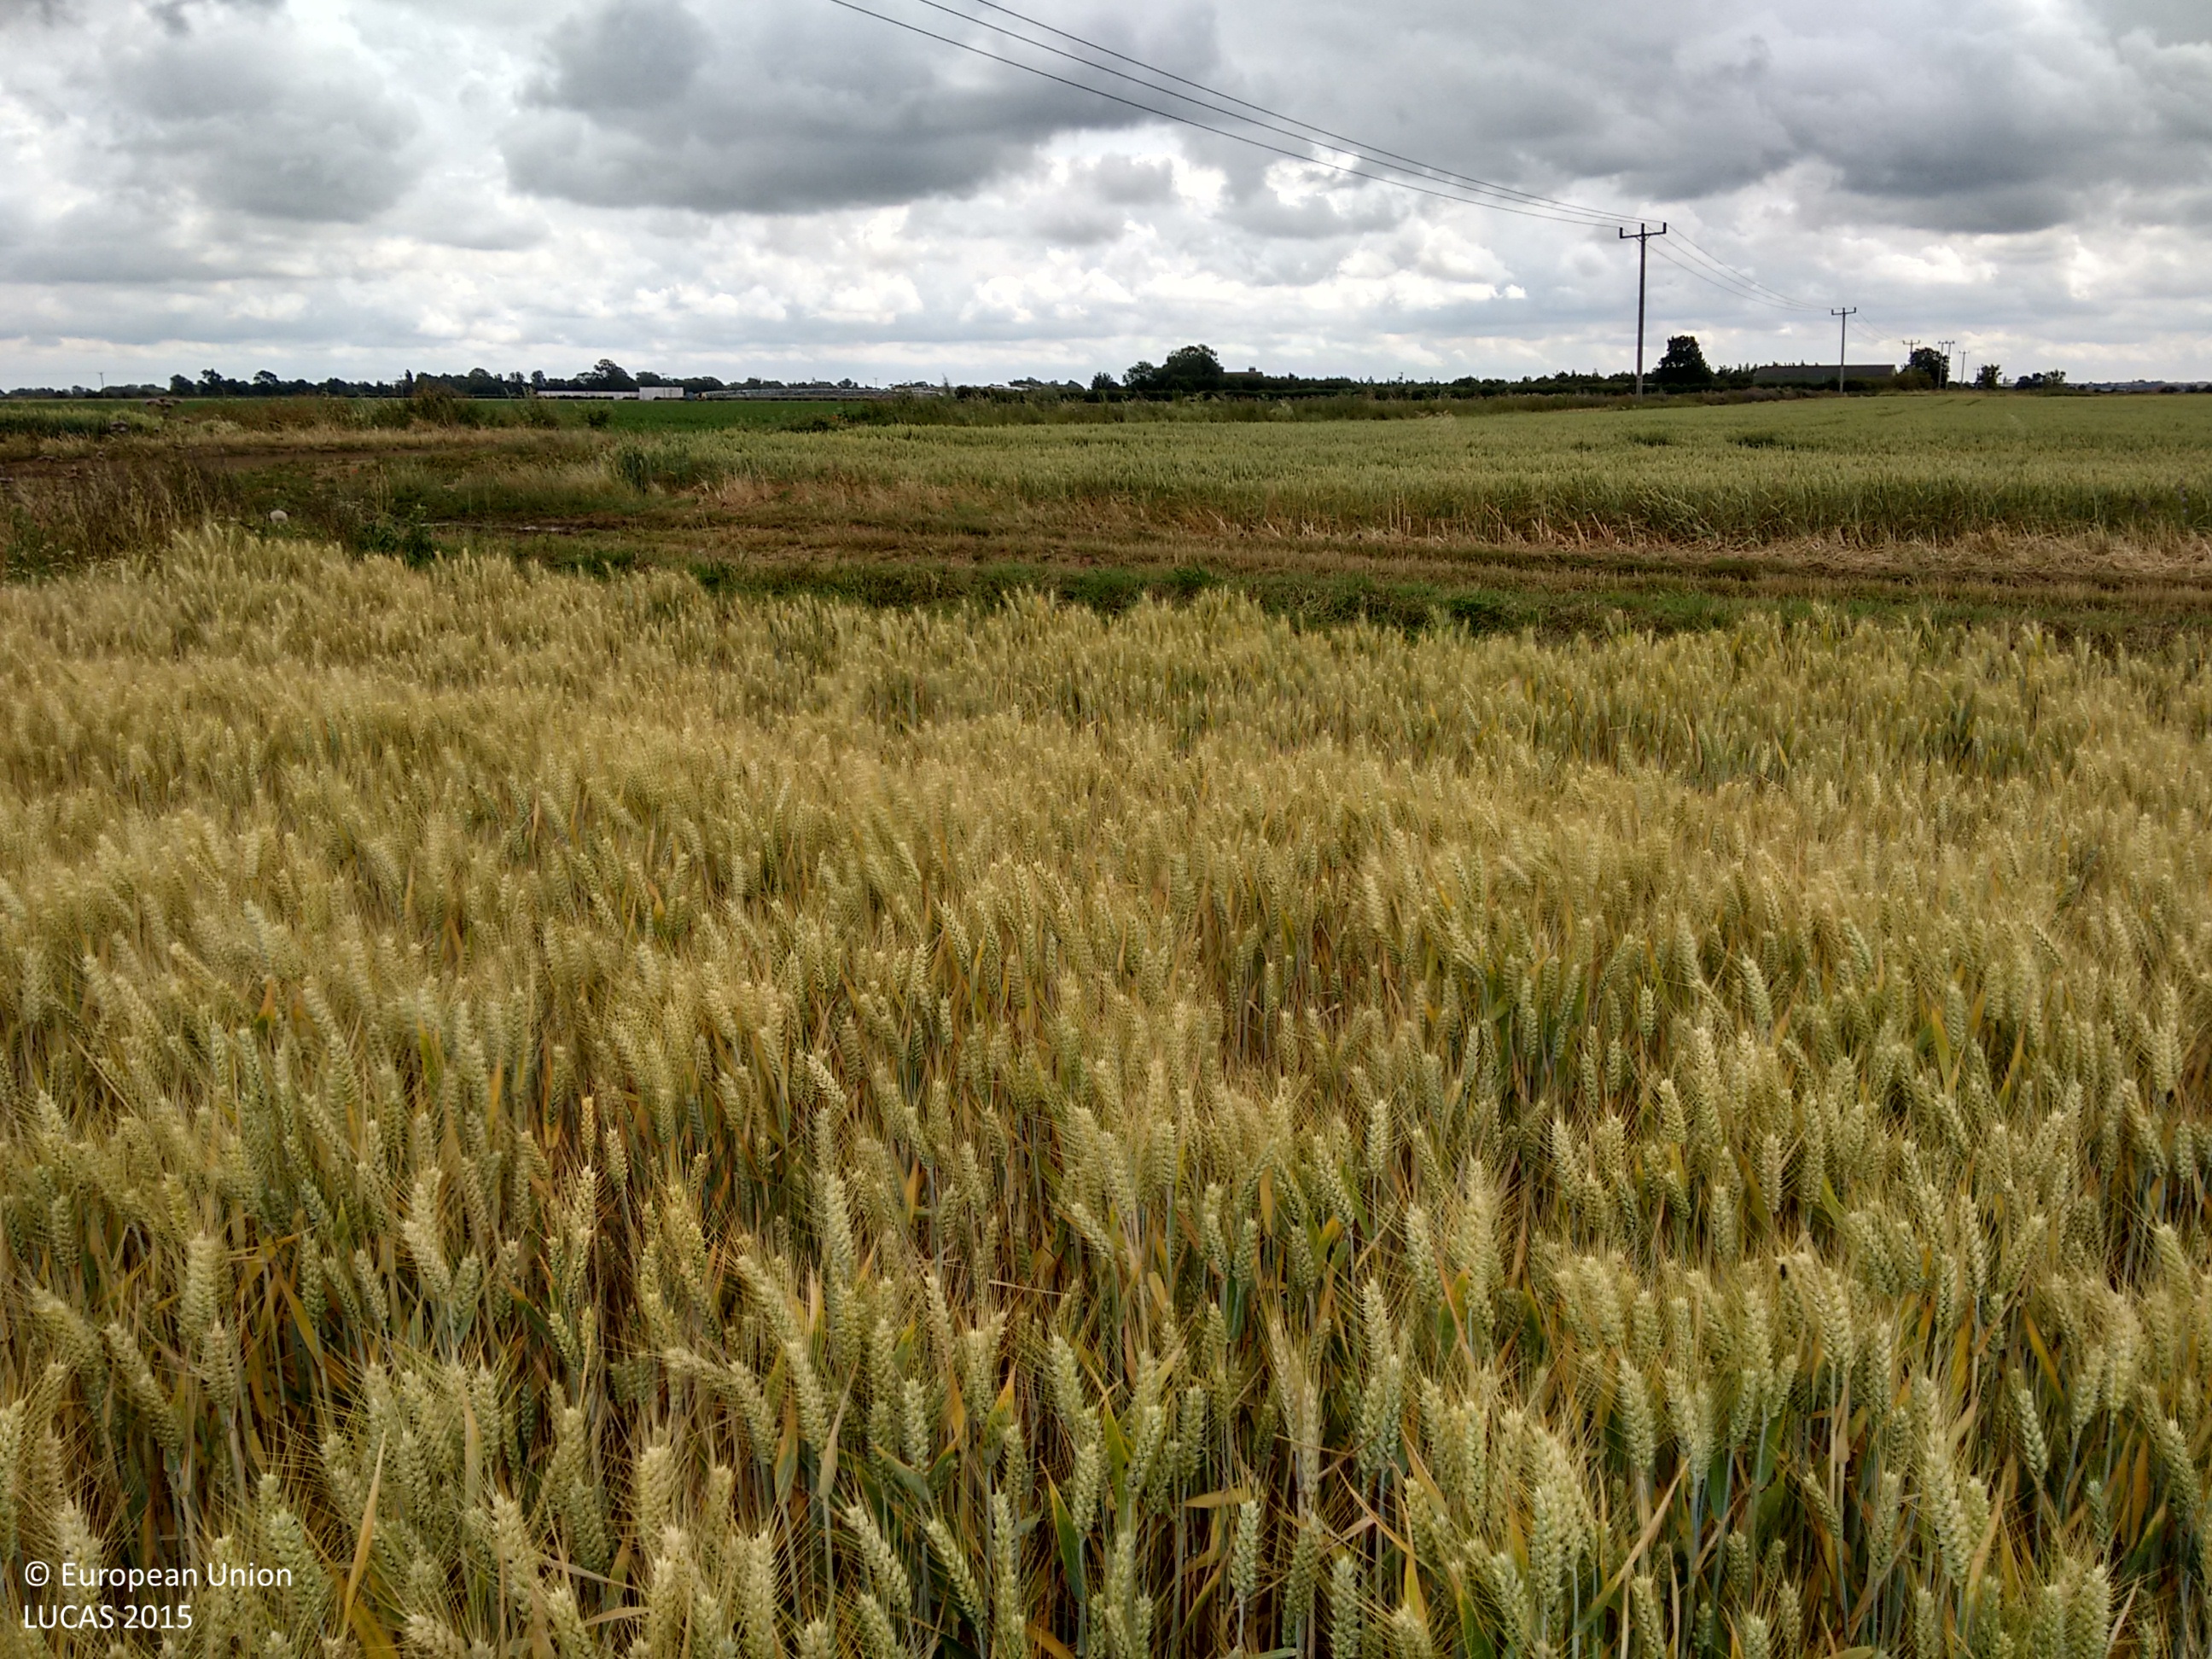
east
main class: Cropland
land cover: Common wheat
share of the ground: > 75 %
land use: Agriculture (excluding fallow land and kitchen gardens)
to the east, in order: Common wheat; Spontaneously vegetated surfaces; Grass margins; Tracks; Electric lines; Tracks; Grass margins; Ditches and canals; Grass margins; Maize
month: July
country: GB
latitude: 52.4312
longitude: 0.0698
